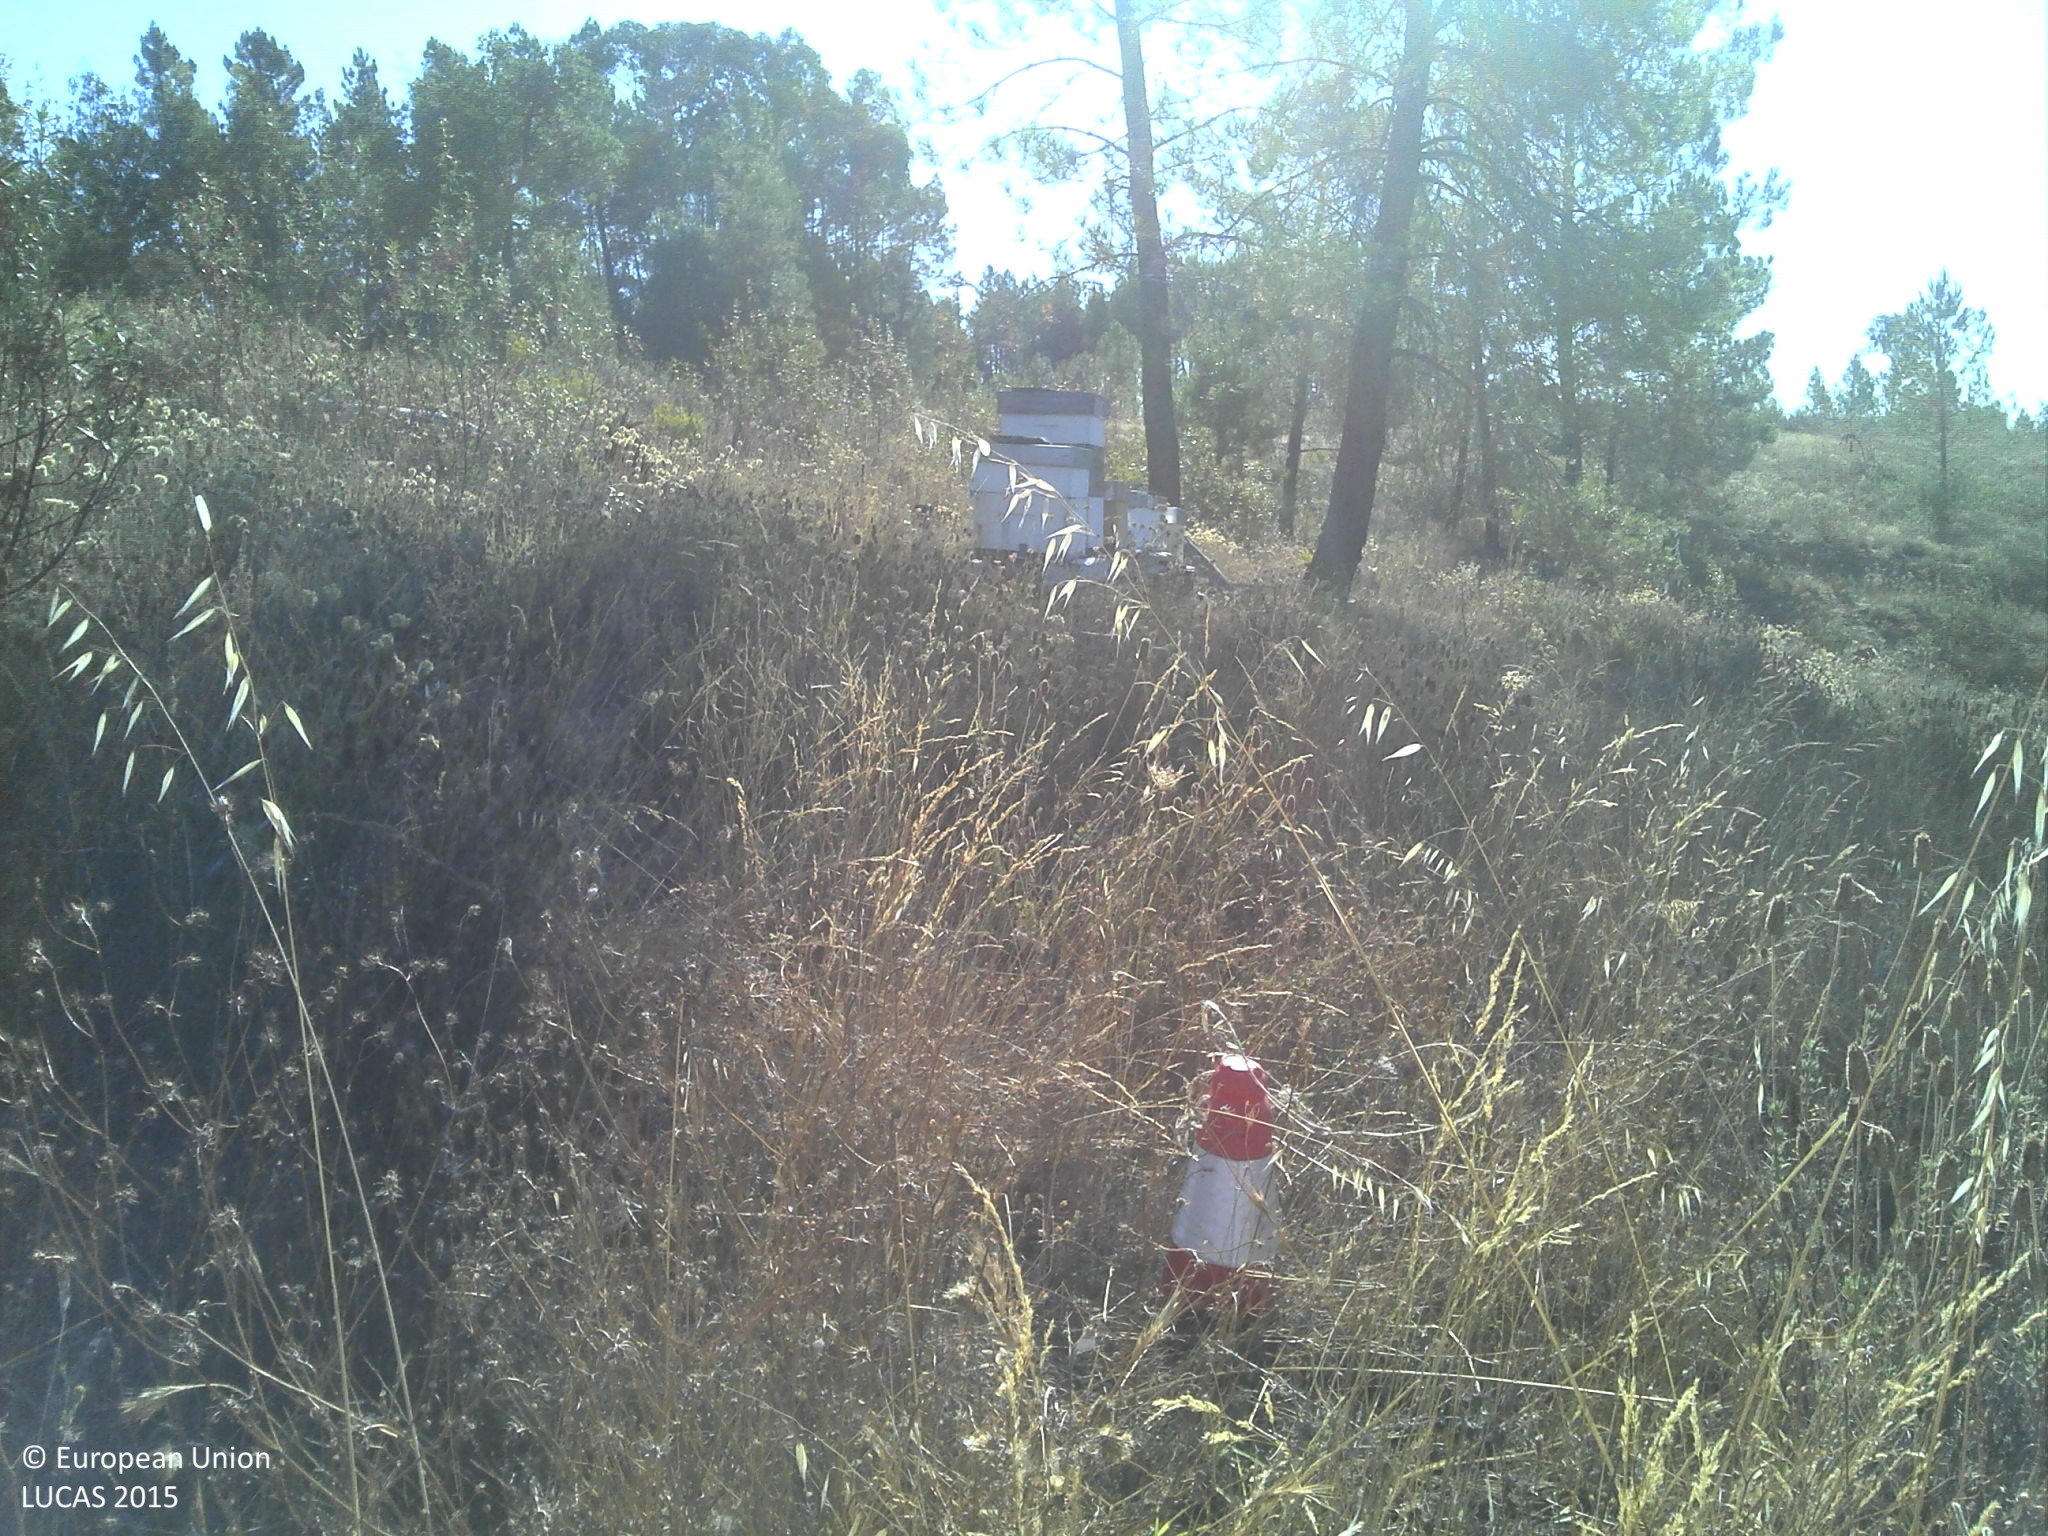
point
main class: Shrubland
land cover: Shrubland with sparse tree cover
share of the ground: 25 - 50 %
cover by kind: shrubs 45 %, unconsolidated bare surface 30 %, herbaceous plants 20 %, broadleaved forest trees 5 %
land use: Forestry
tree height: > 5 m
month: July
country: PT
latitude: 39.8360
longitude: -7.6427
